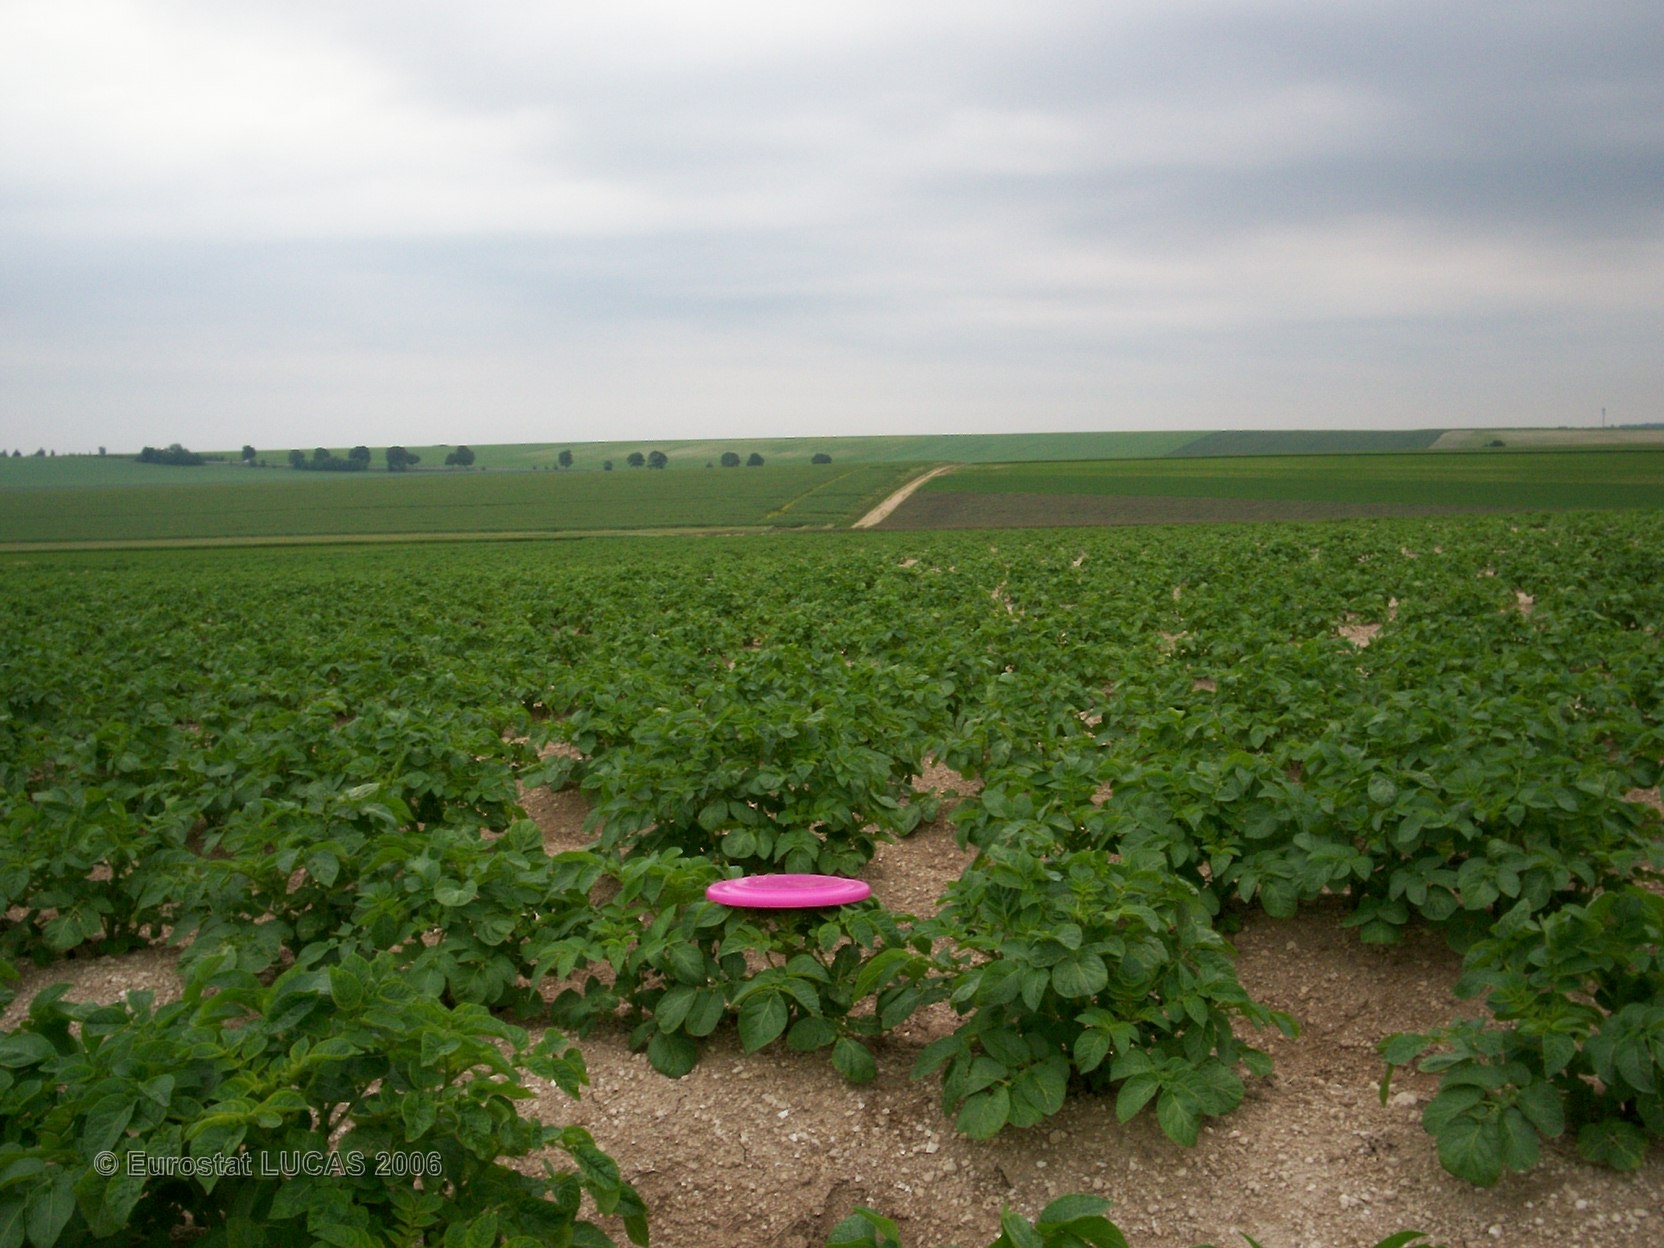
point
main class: Cropland
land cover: Potatoes
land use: Agriculture (excluding fallow land and kitchen gardens)
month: June
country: FR
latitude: 48.7502
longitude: 4.4340
